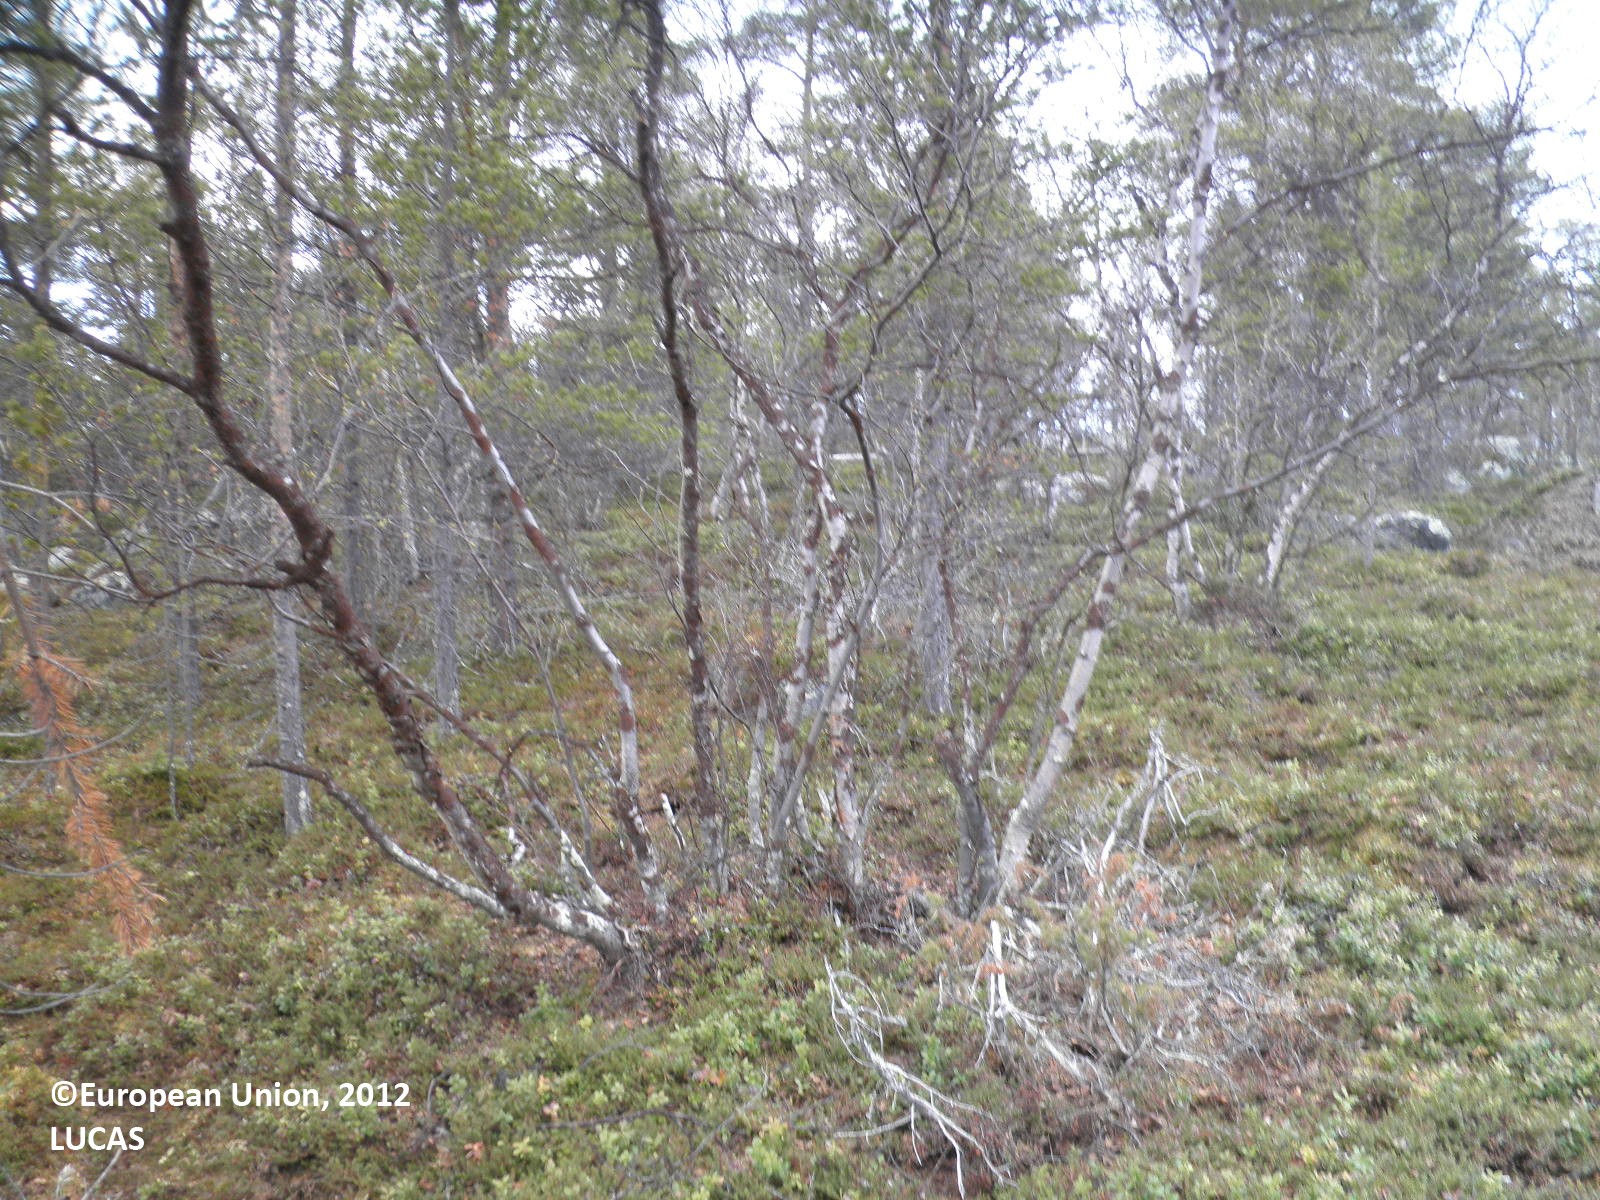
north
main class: Woodland
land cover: Pine dominated mixed woodland
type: boreal forest
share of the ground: > 75 %
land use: Forestry
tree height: > 5 m
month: May
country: FI
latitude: 69.7331
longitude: 27.0396
